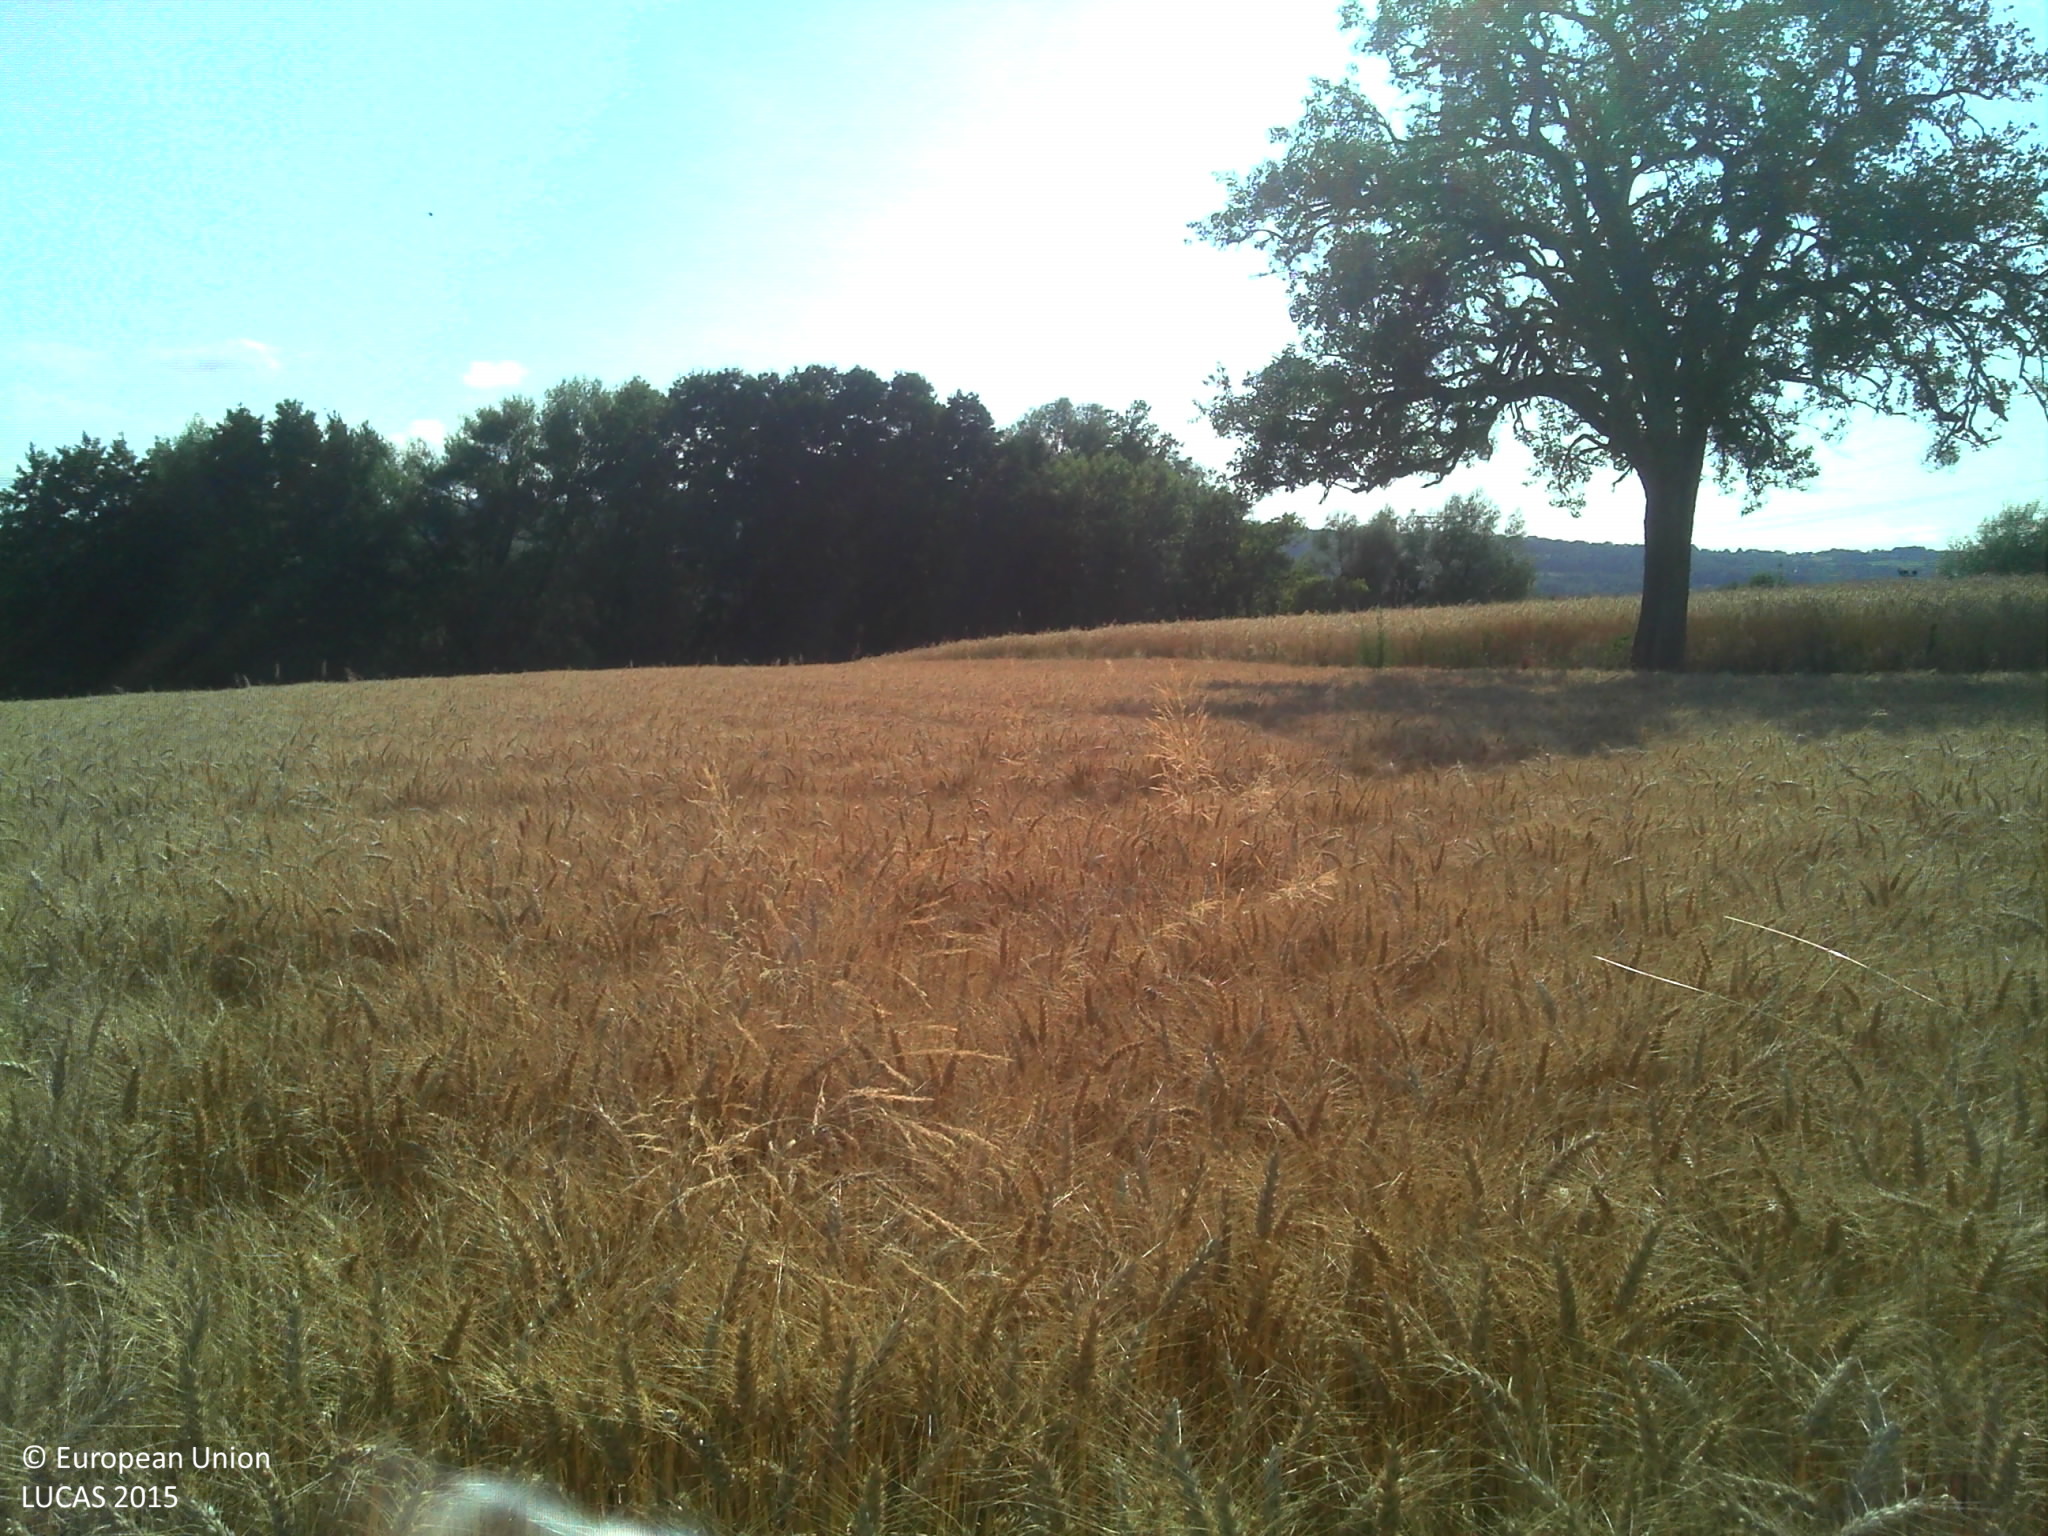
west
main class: Cropland
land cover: Rye
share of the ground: > 75 %
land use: Agriculture (excluding fallow land and kitchen gardens)
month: July
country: FR
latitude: 46.0895
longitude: 6.3177
